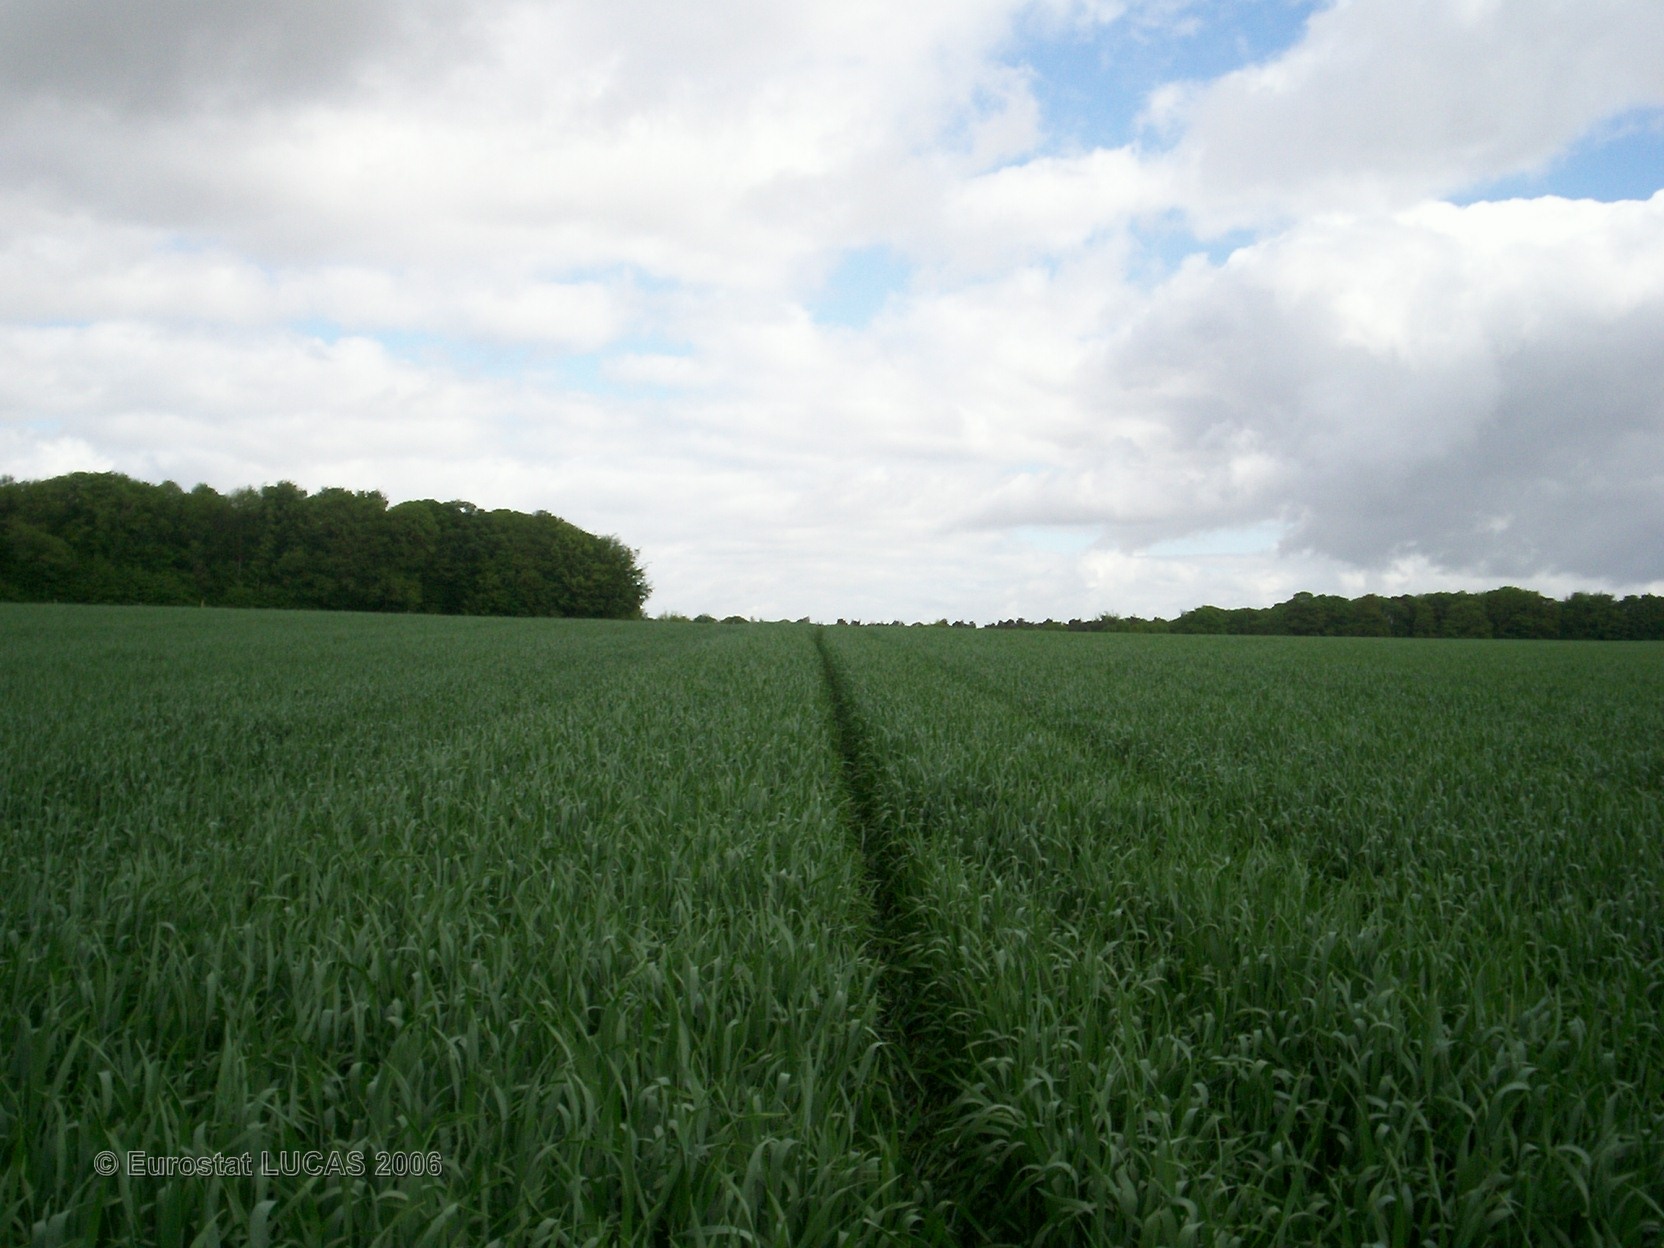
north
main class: Cropland
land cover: Common wheat
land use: Agriculture (excluding fallow land and kitchen gardens)
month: May
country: FR
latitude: 47.9352
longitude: -2.9028
